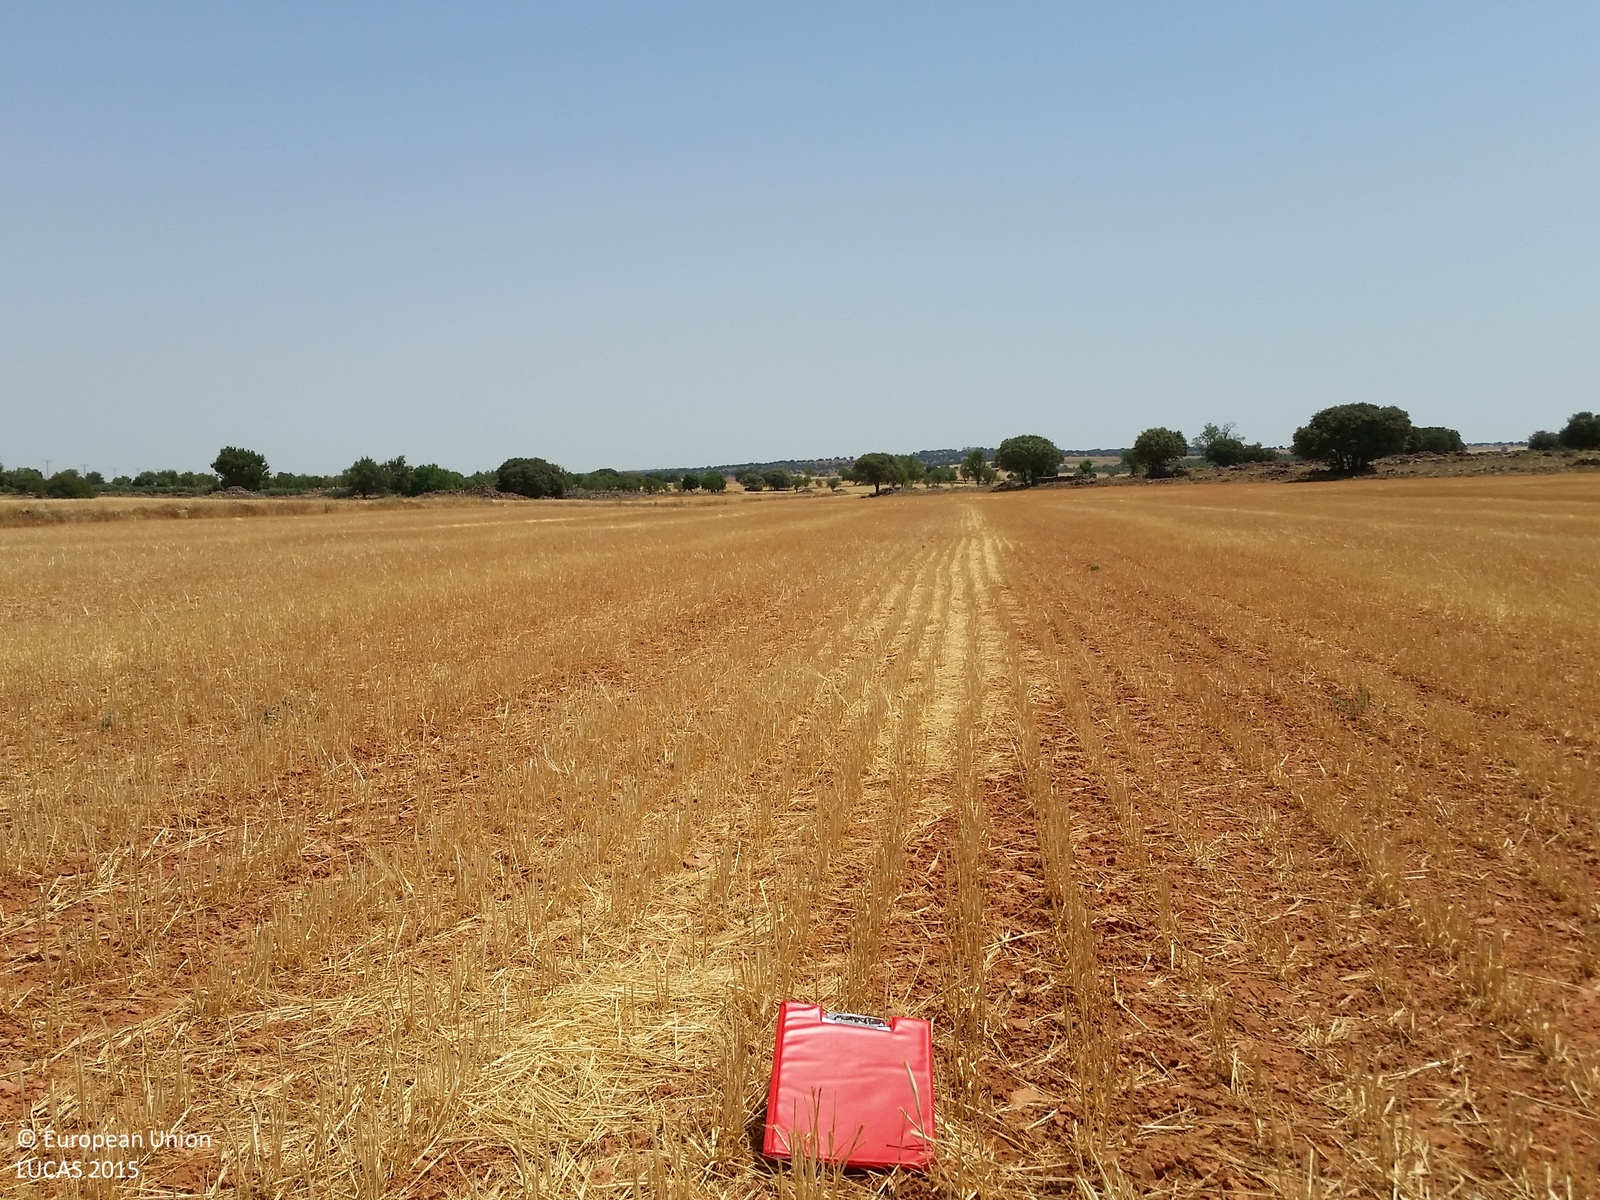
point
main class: Cropland
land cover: Barley
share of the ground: < 10 %
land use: Agriculture (excluding fallow land and kitchen gardens)
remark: Harvested field
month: June
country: ES
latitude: 38.7795
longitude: -2.5618
